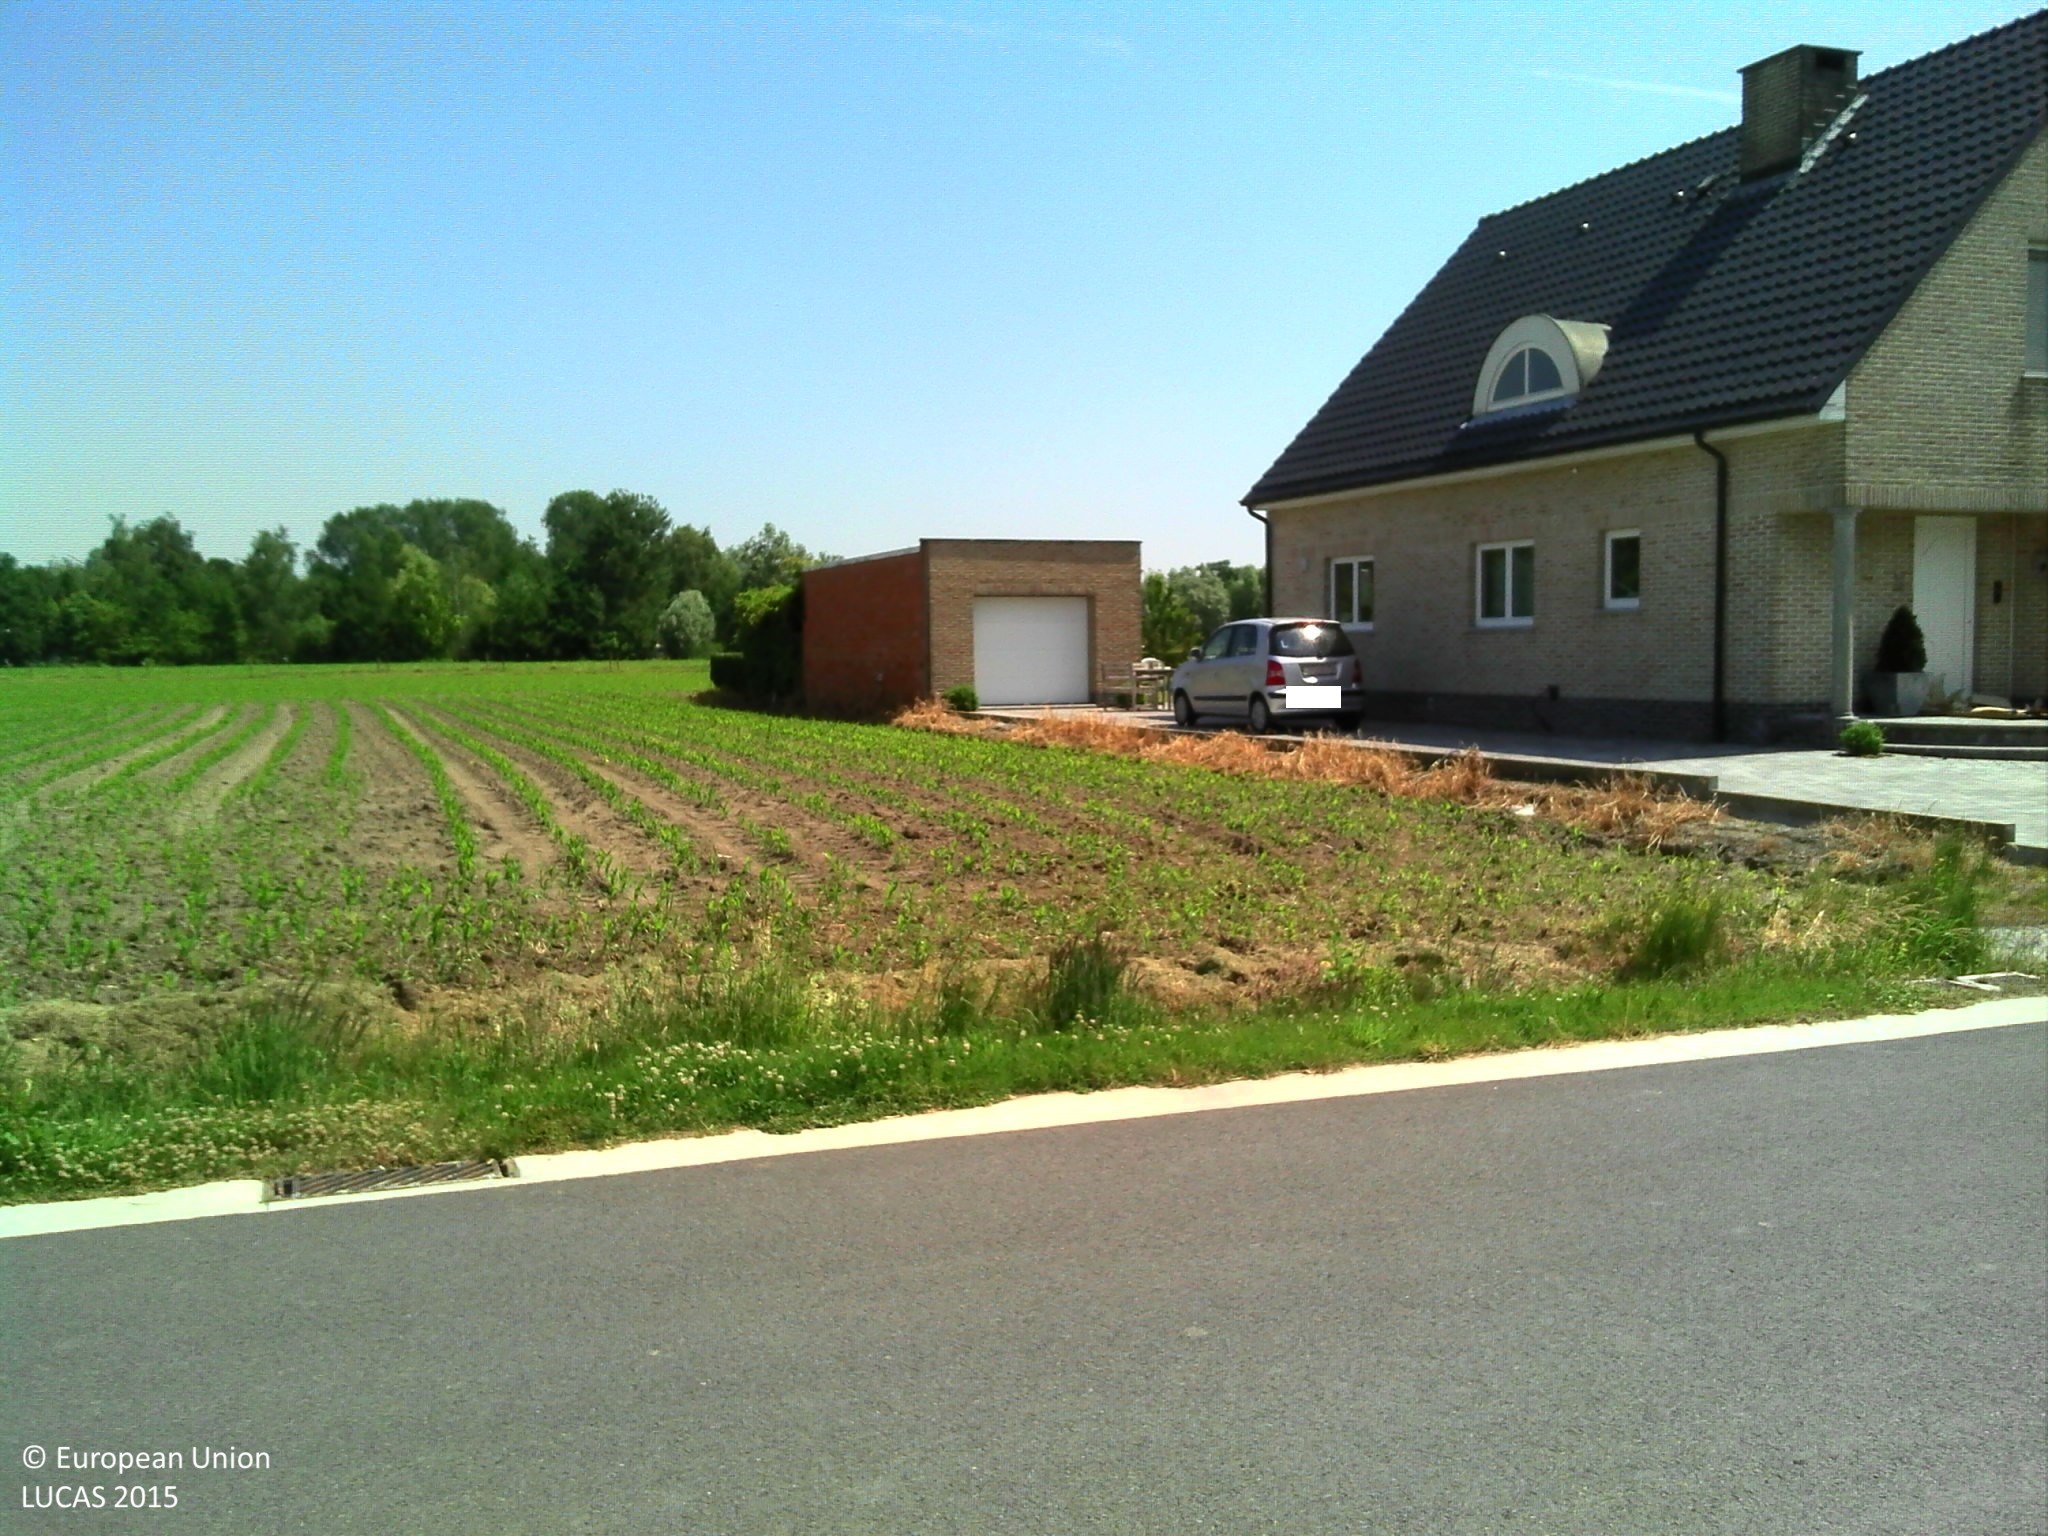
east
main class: Grassland
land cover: Grassland with sparse tree/shrub cover
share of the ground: > 75 %
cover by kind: herbaceous plants 95 %, broadleaved forest trees 5 %
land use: Residential
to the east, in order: Grassland with sparse tree/shrub cover; Artificial constructions in urban areas; Ditches and canals; Fences; Grassland without tree/shrub cover; Broadleaved woodland; Maize; Fences; Grassland without tree/shrub cover; Maize; Single bushes/trees; Grass margins; Tracks; Grassland without tree/shrub cover
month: June
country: BE
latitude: 51.0592
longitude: 4.1018
